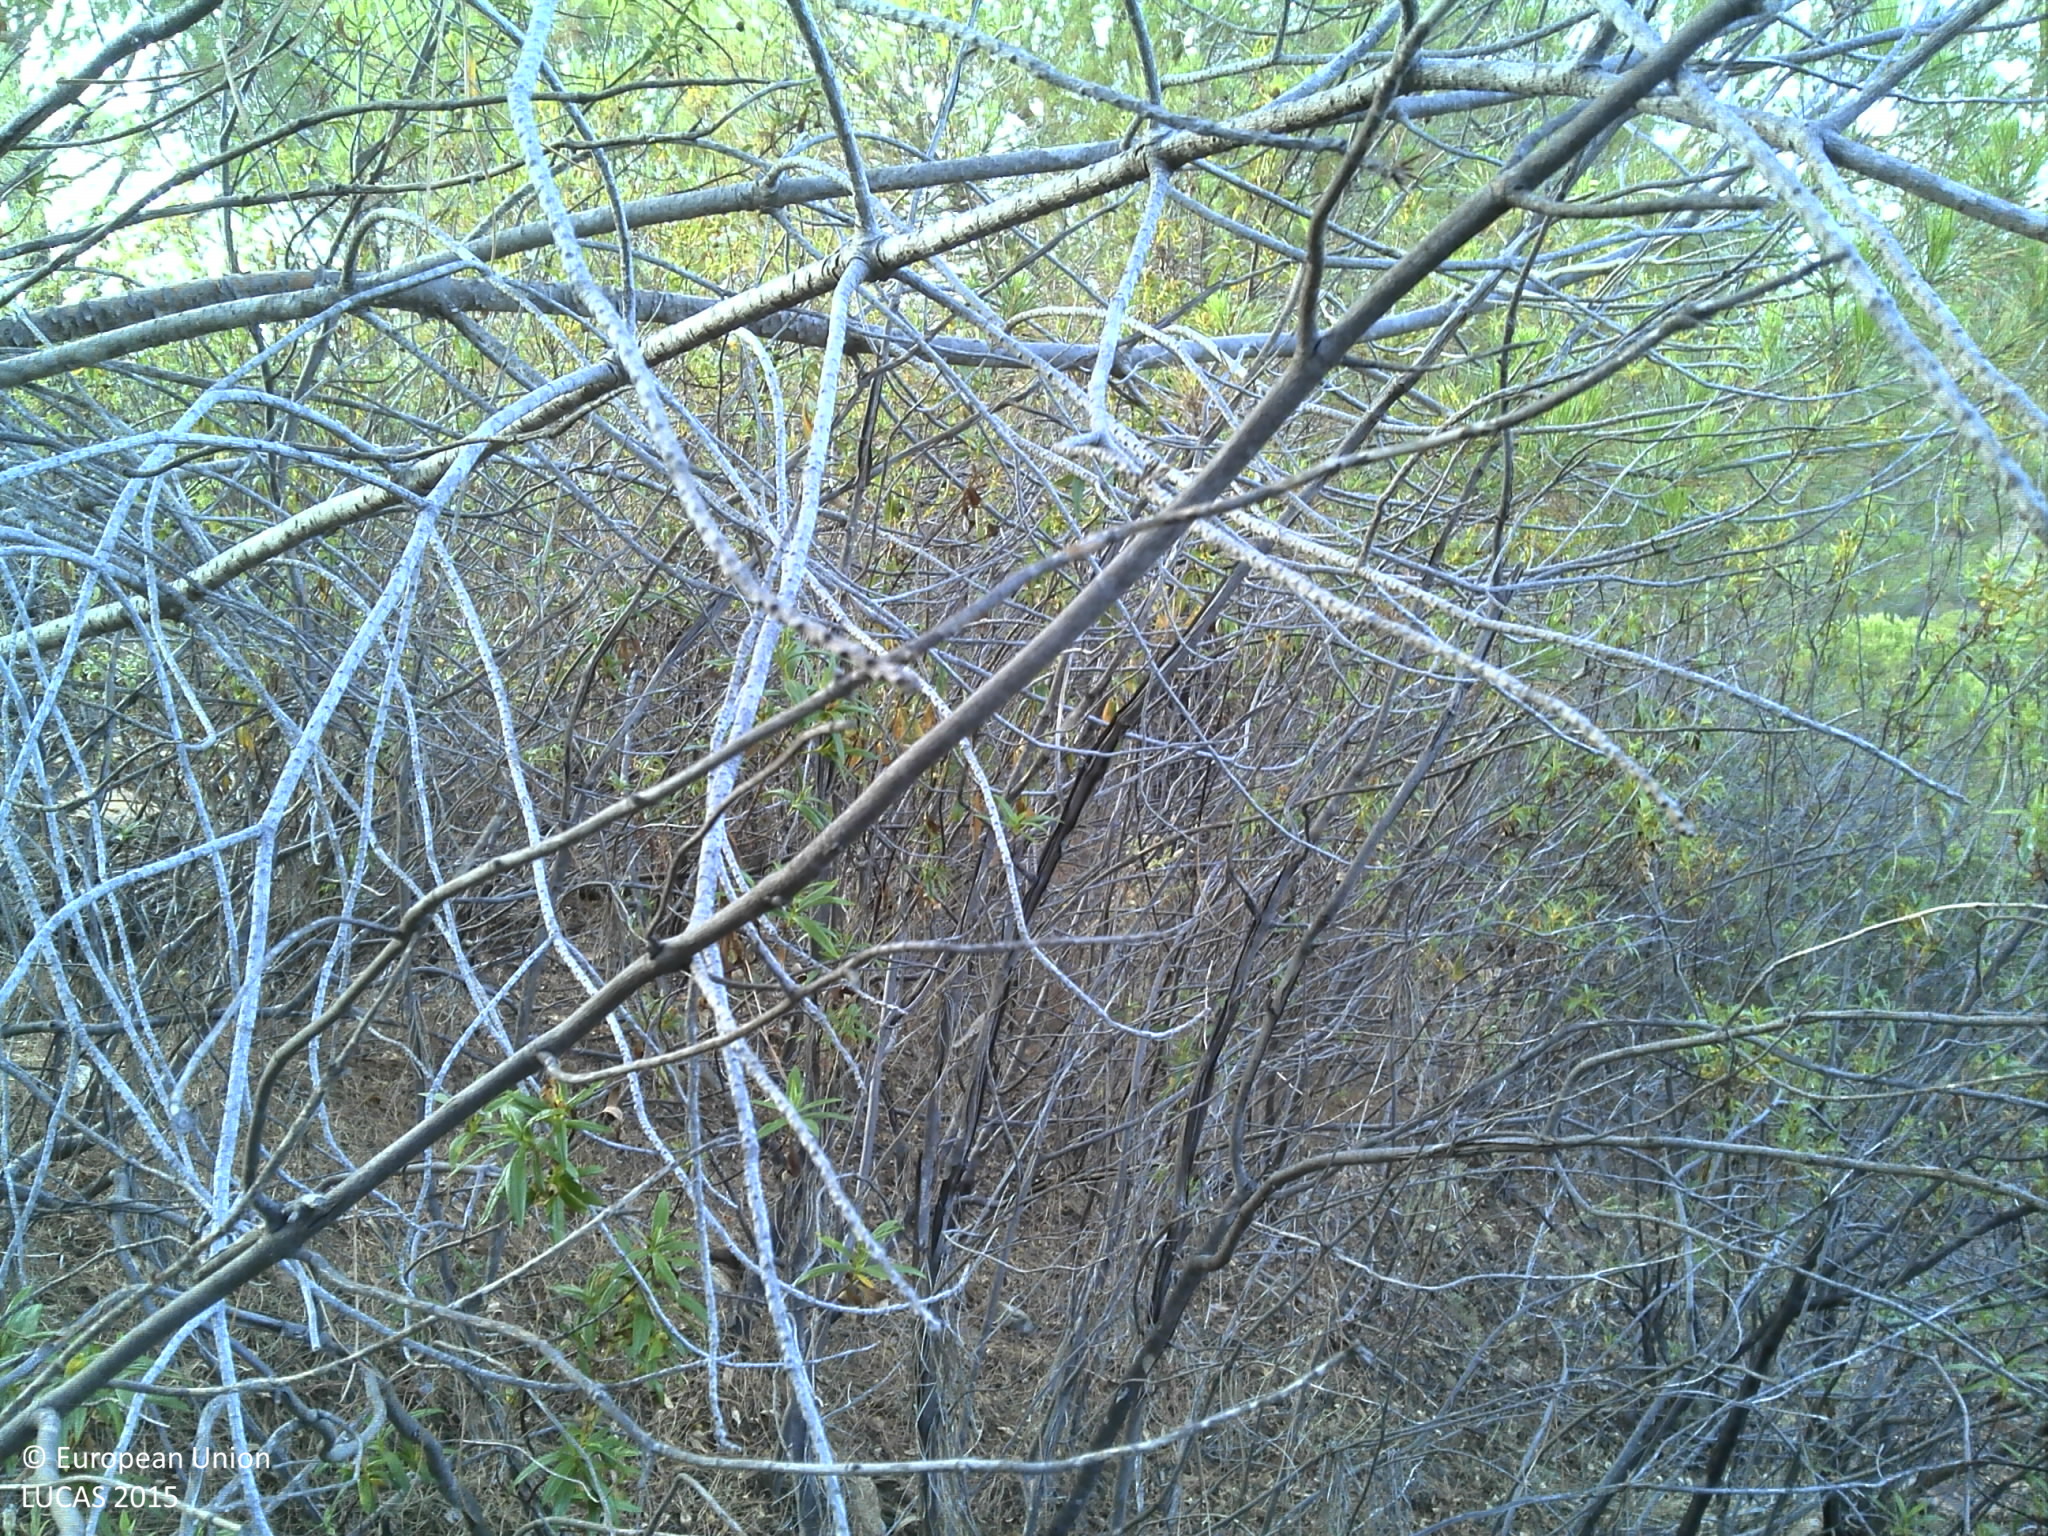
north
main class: Woodland
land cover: Pine dominated coniferous woodland
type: coniferous forest of the mediterranean region
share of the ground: 10 - 25 %
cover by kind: shrubs 90 %, coniferous forest trees 10 %
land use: Forestry
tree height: > 5 m
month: June
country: PT
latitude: 37.3454
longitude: -7.7222
